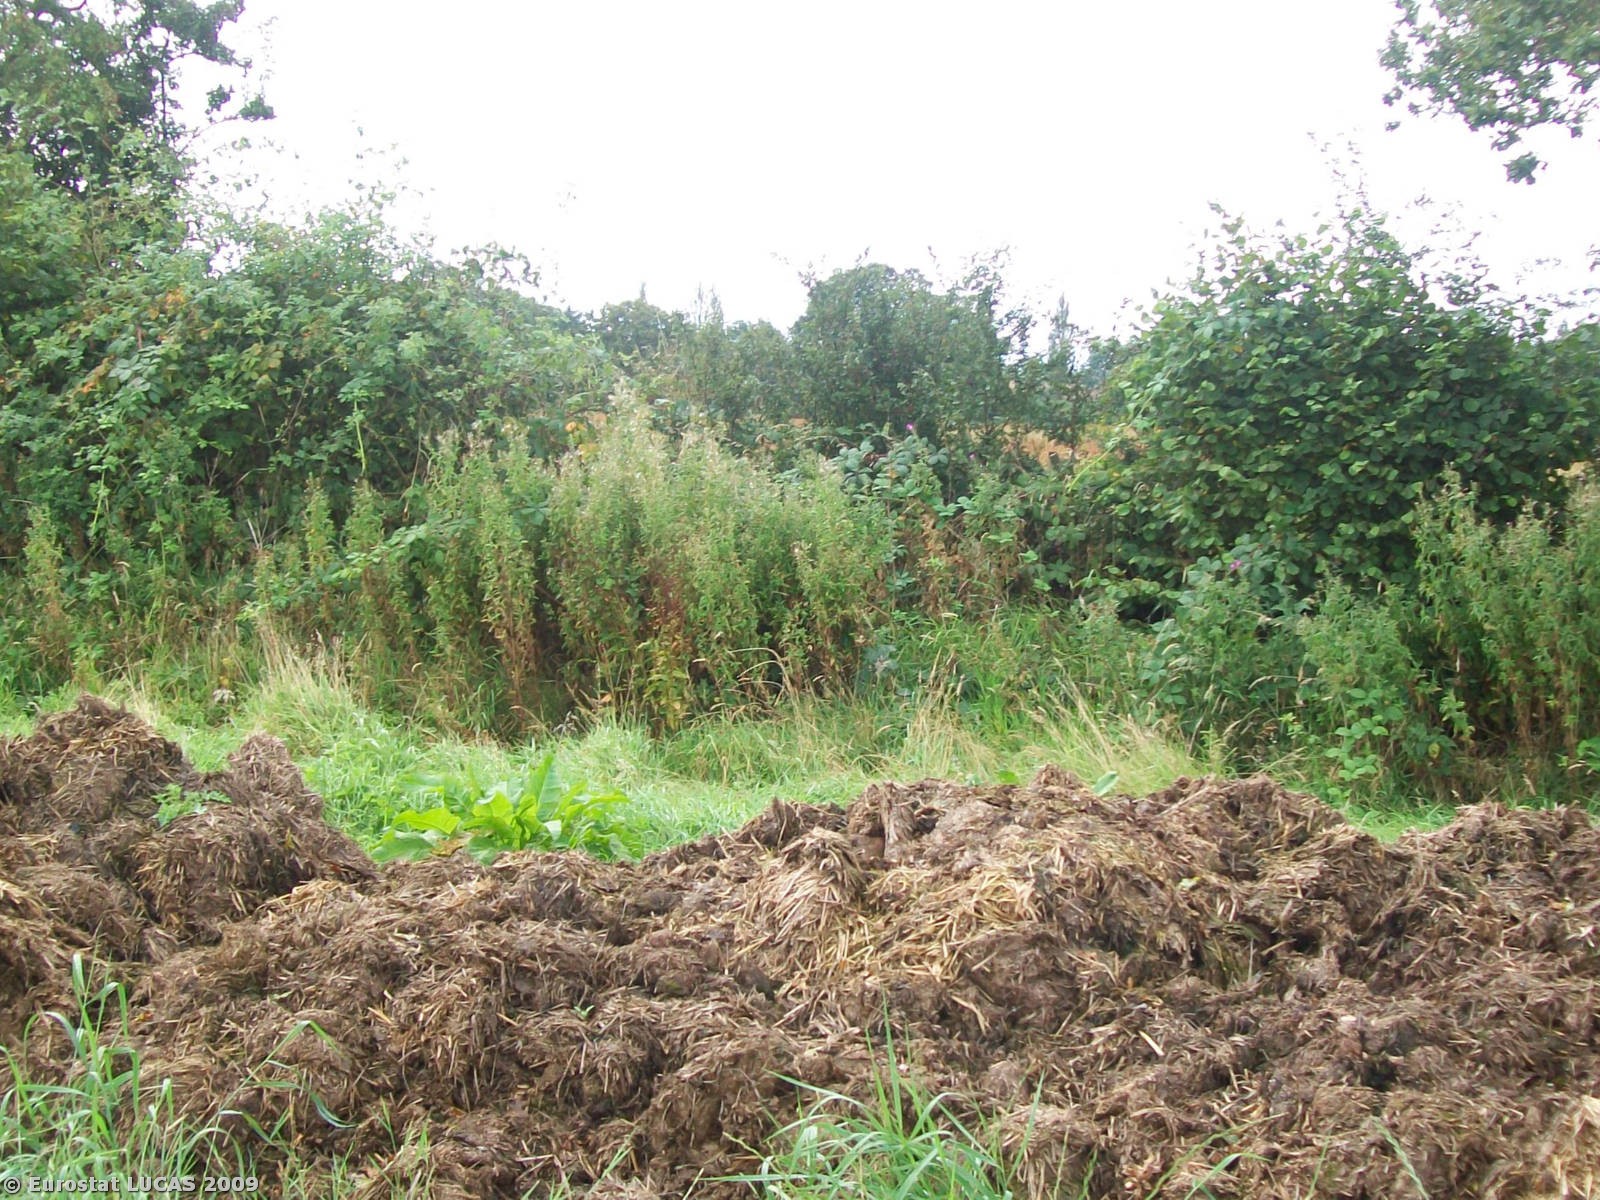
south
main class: Cropland
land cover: Common wheat
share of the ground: > 75 %
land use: Agriculture (excluding fallow land and kitchen gardens)
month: September
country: GB
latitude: 52.5302
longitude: -2.5227
